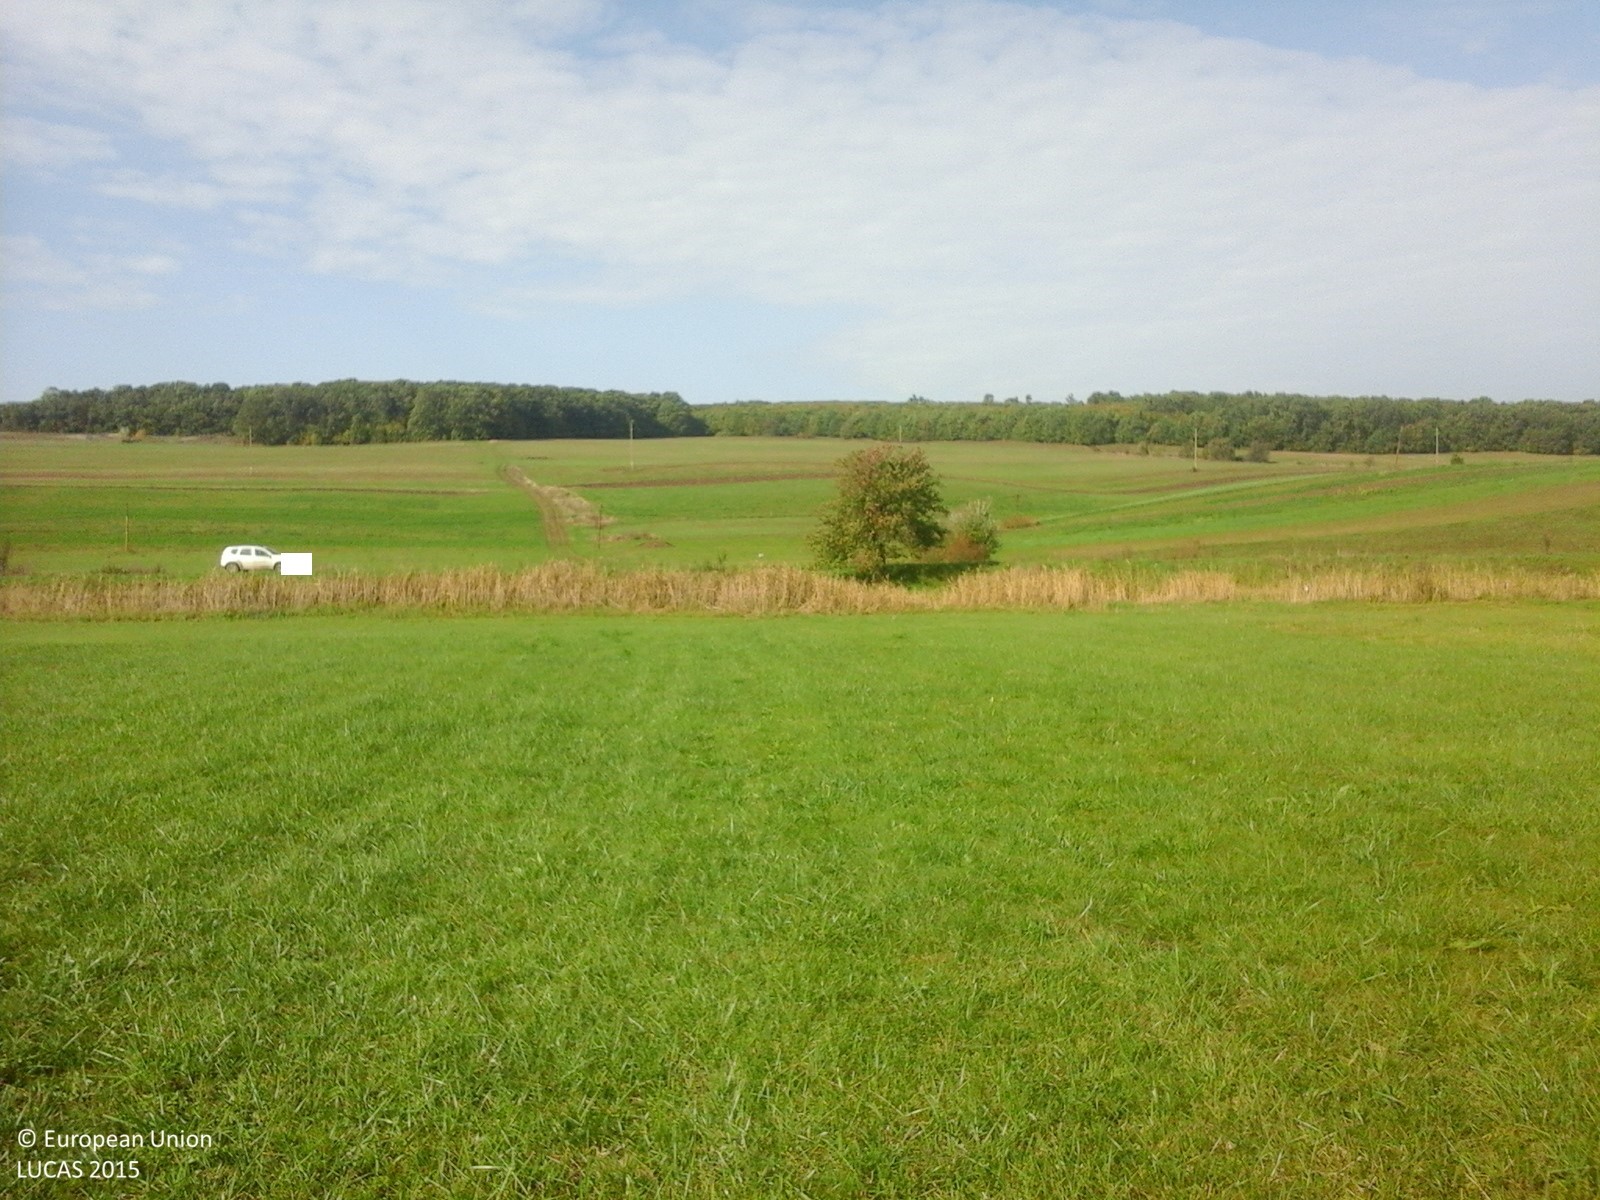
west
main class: Grassland
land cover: Grassland without tree/shrub cover
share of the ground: > 75 %
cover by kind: herbaceous plants 100 %
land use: Agriculture (excluding fallow land and kitchen gardens)
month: October
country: RO
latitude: 46.2011
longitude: 25.3830
